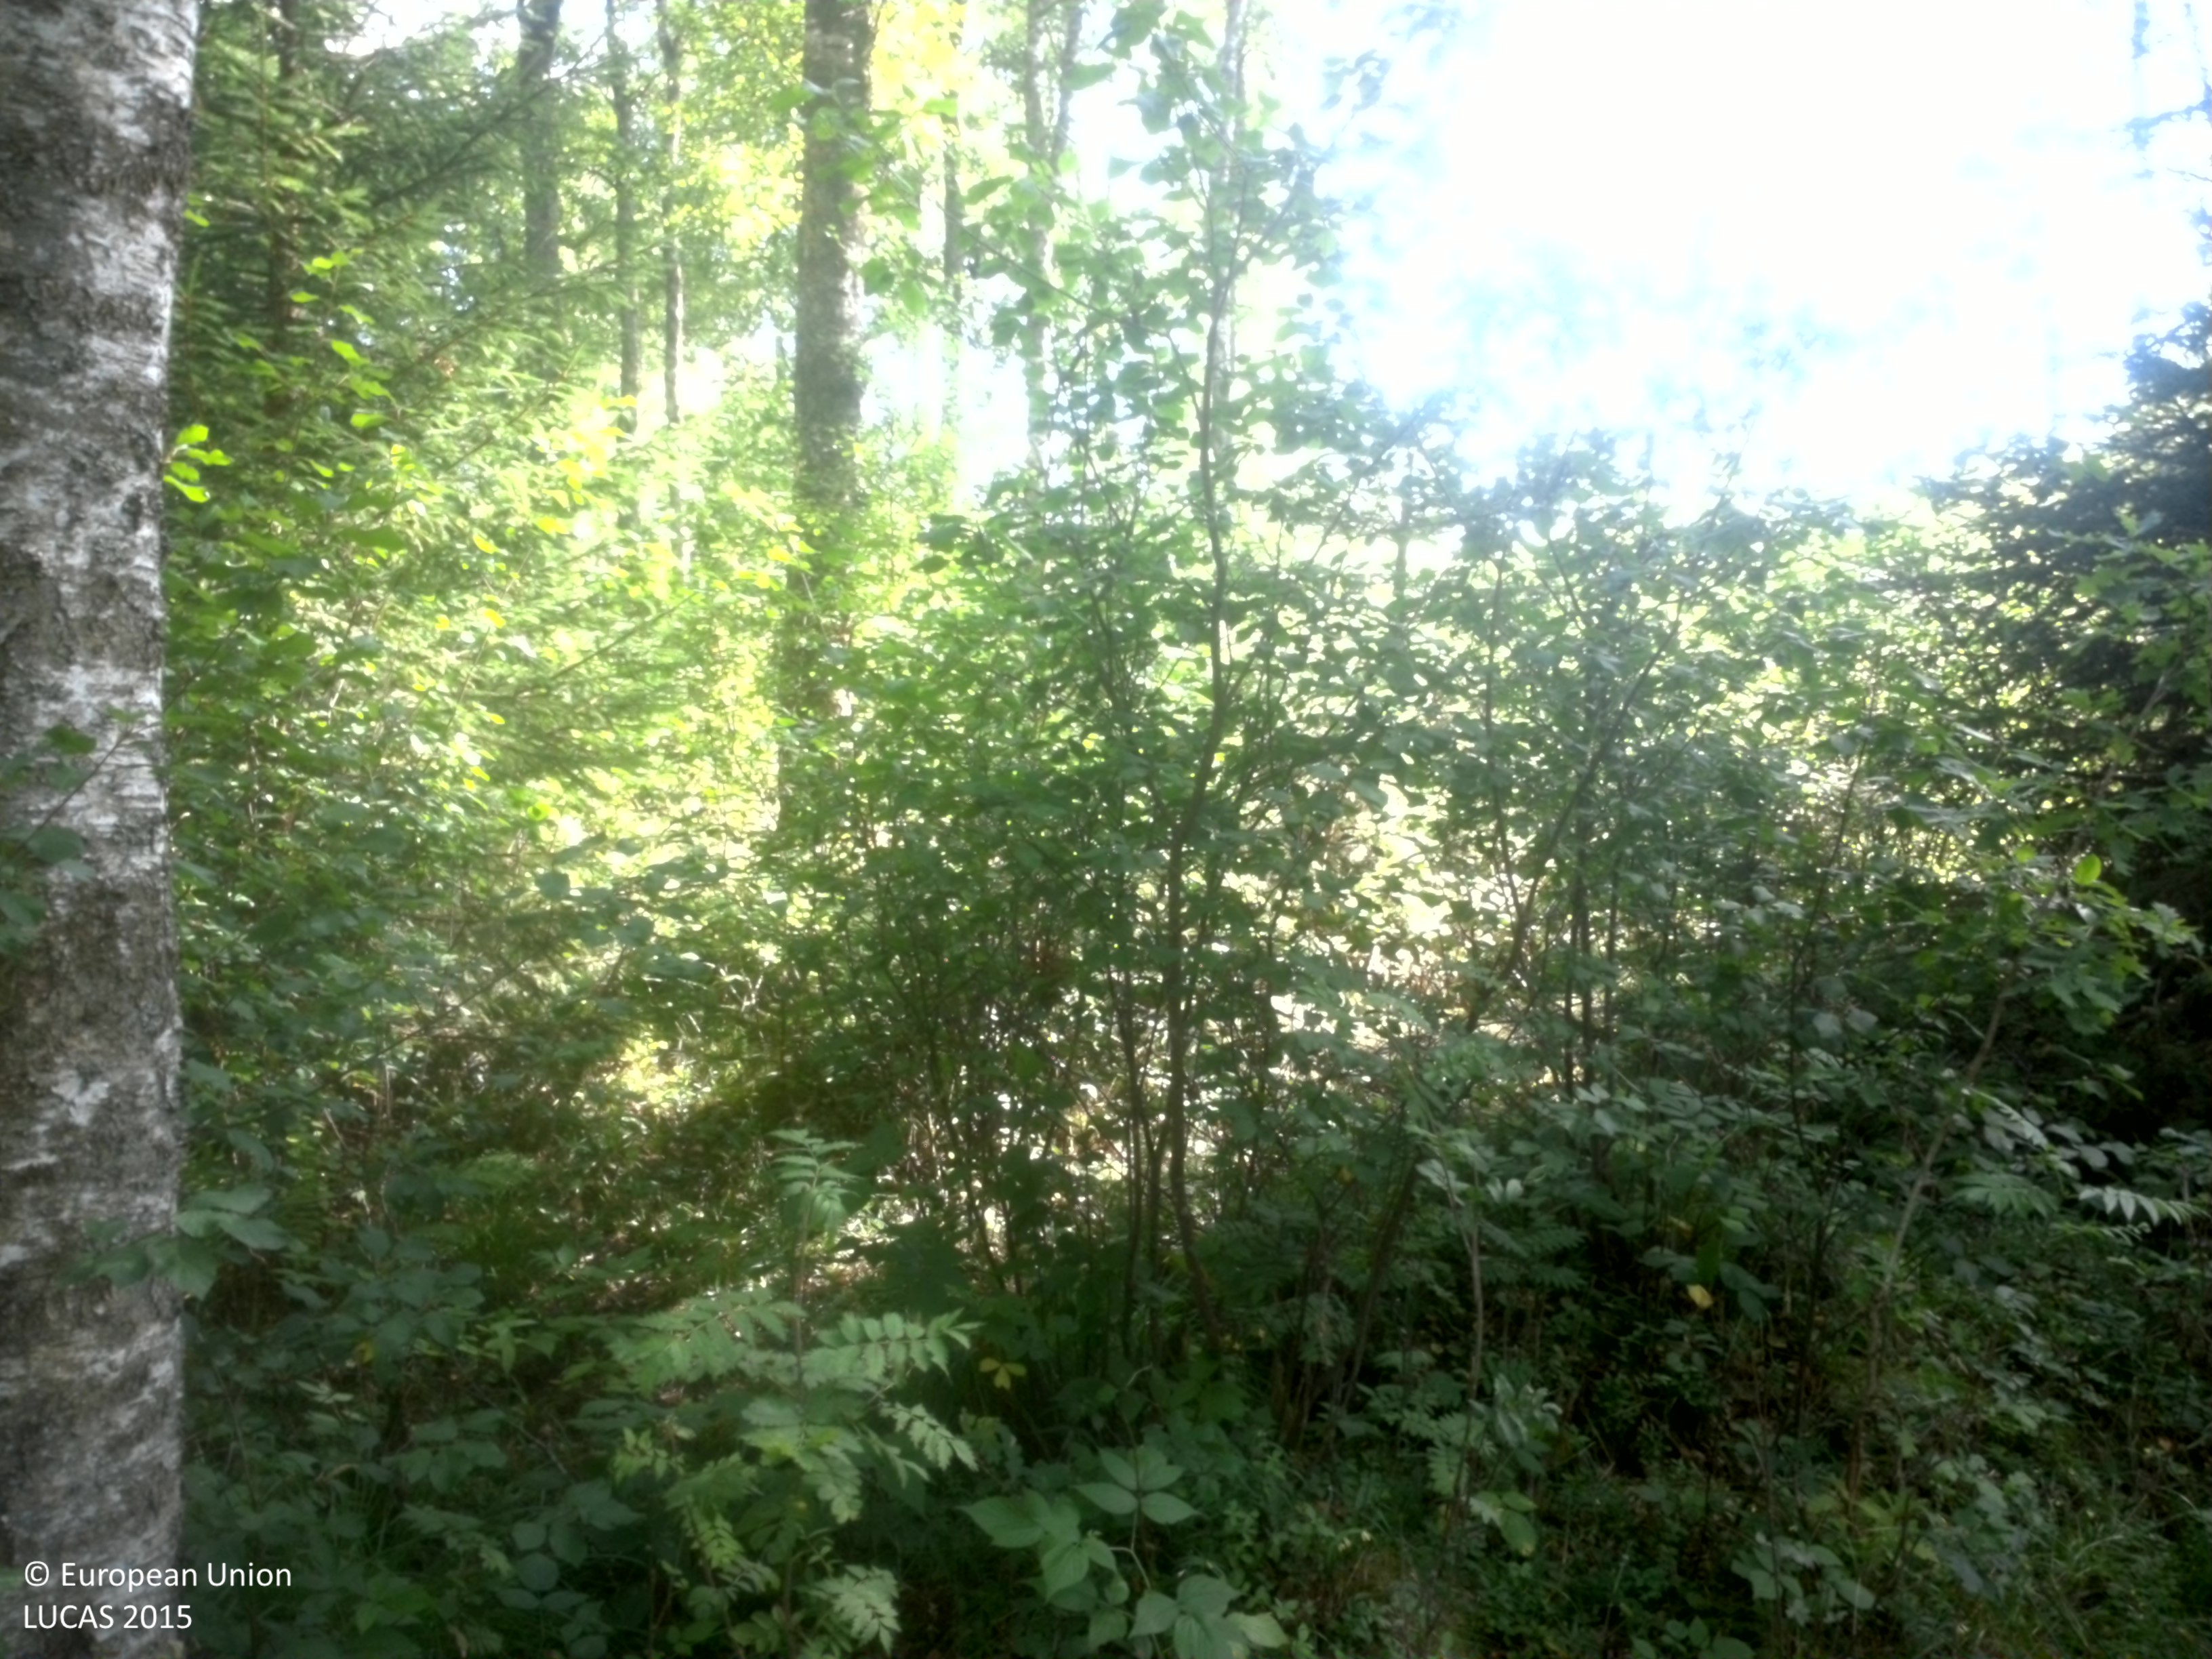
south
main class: Woodland
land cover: Broadleaved woodland
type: boreal forest
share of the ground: 50 - 75 %
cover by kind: broadleaved forest trees 55 %, herbaceous plants 35 %, coniferous forest trees 5 %, shrubs 5 %
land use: Forestry
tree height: > 5 m
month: August
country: SE
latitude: 58.2865
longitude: 13.3203
